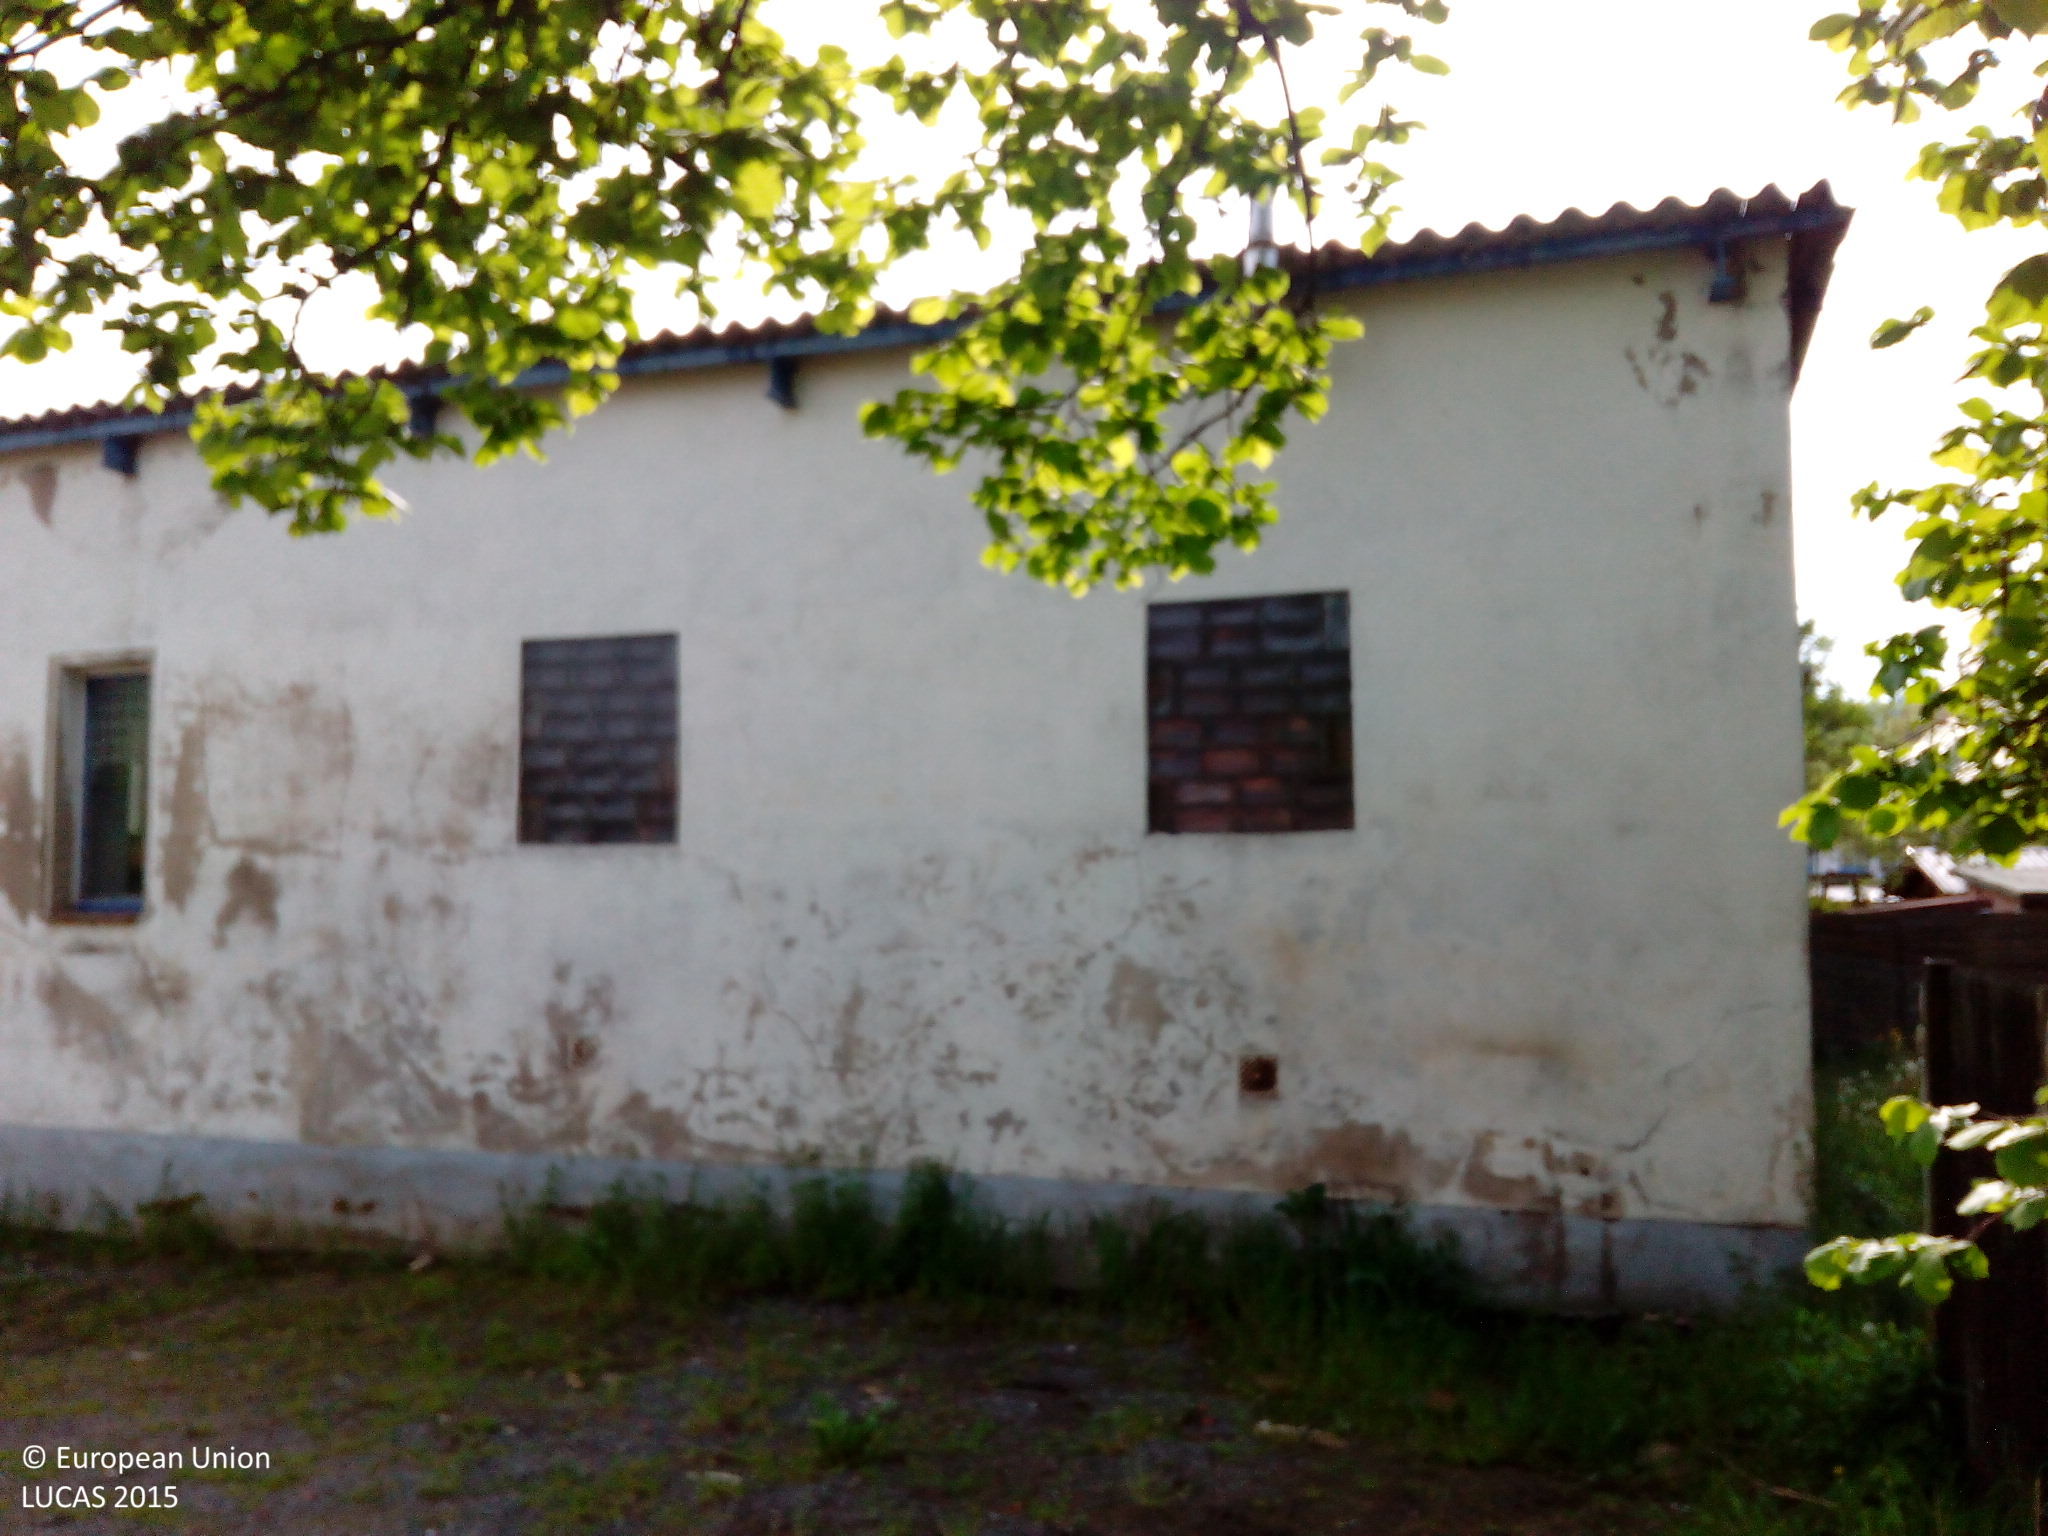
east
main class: Woodland
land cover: Broadleaved woodland
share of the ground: 10 - 25 %
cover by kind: consolidated bare surface 55 %, herbaceous plants 25 %, broadleaved forest trees 20 %
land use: Residential
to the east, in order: Broadleaved woodland; Artificial constructions in urban areas
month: May
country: DE
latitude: 50.8444
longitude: 13.0819
